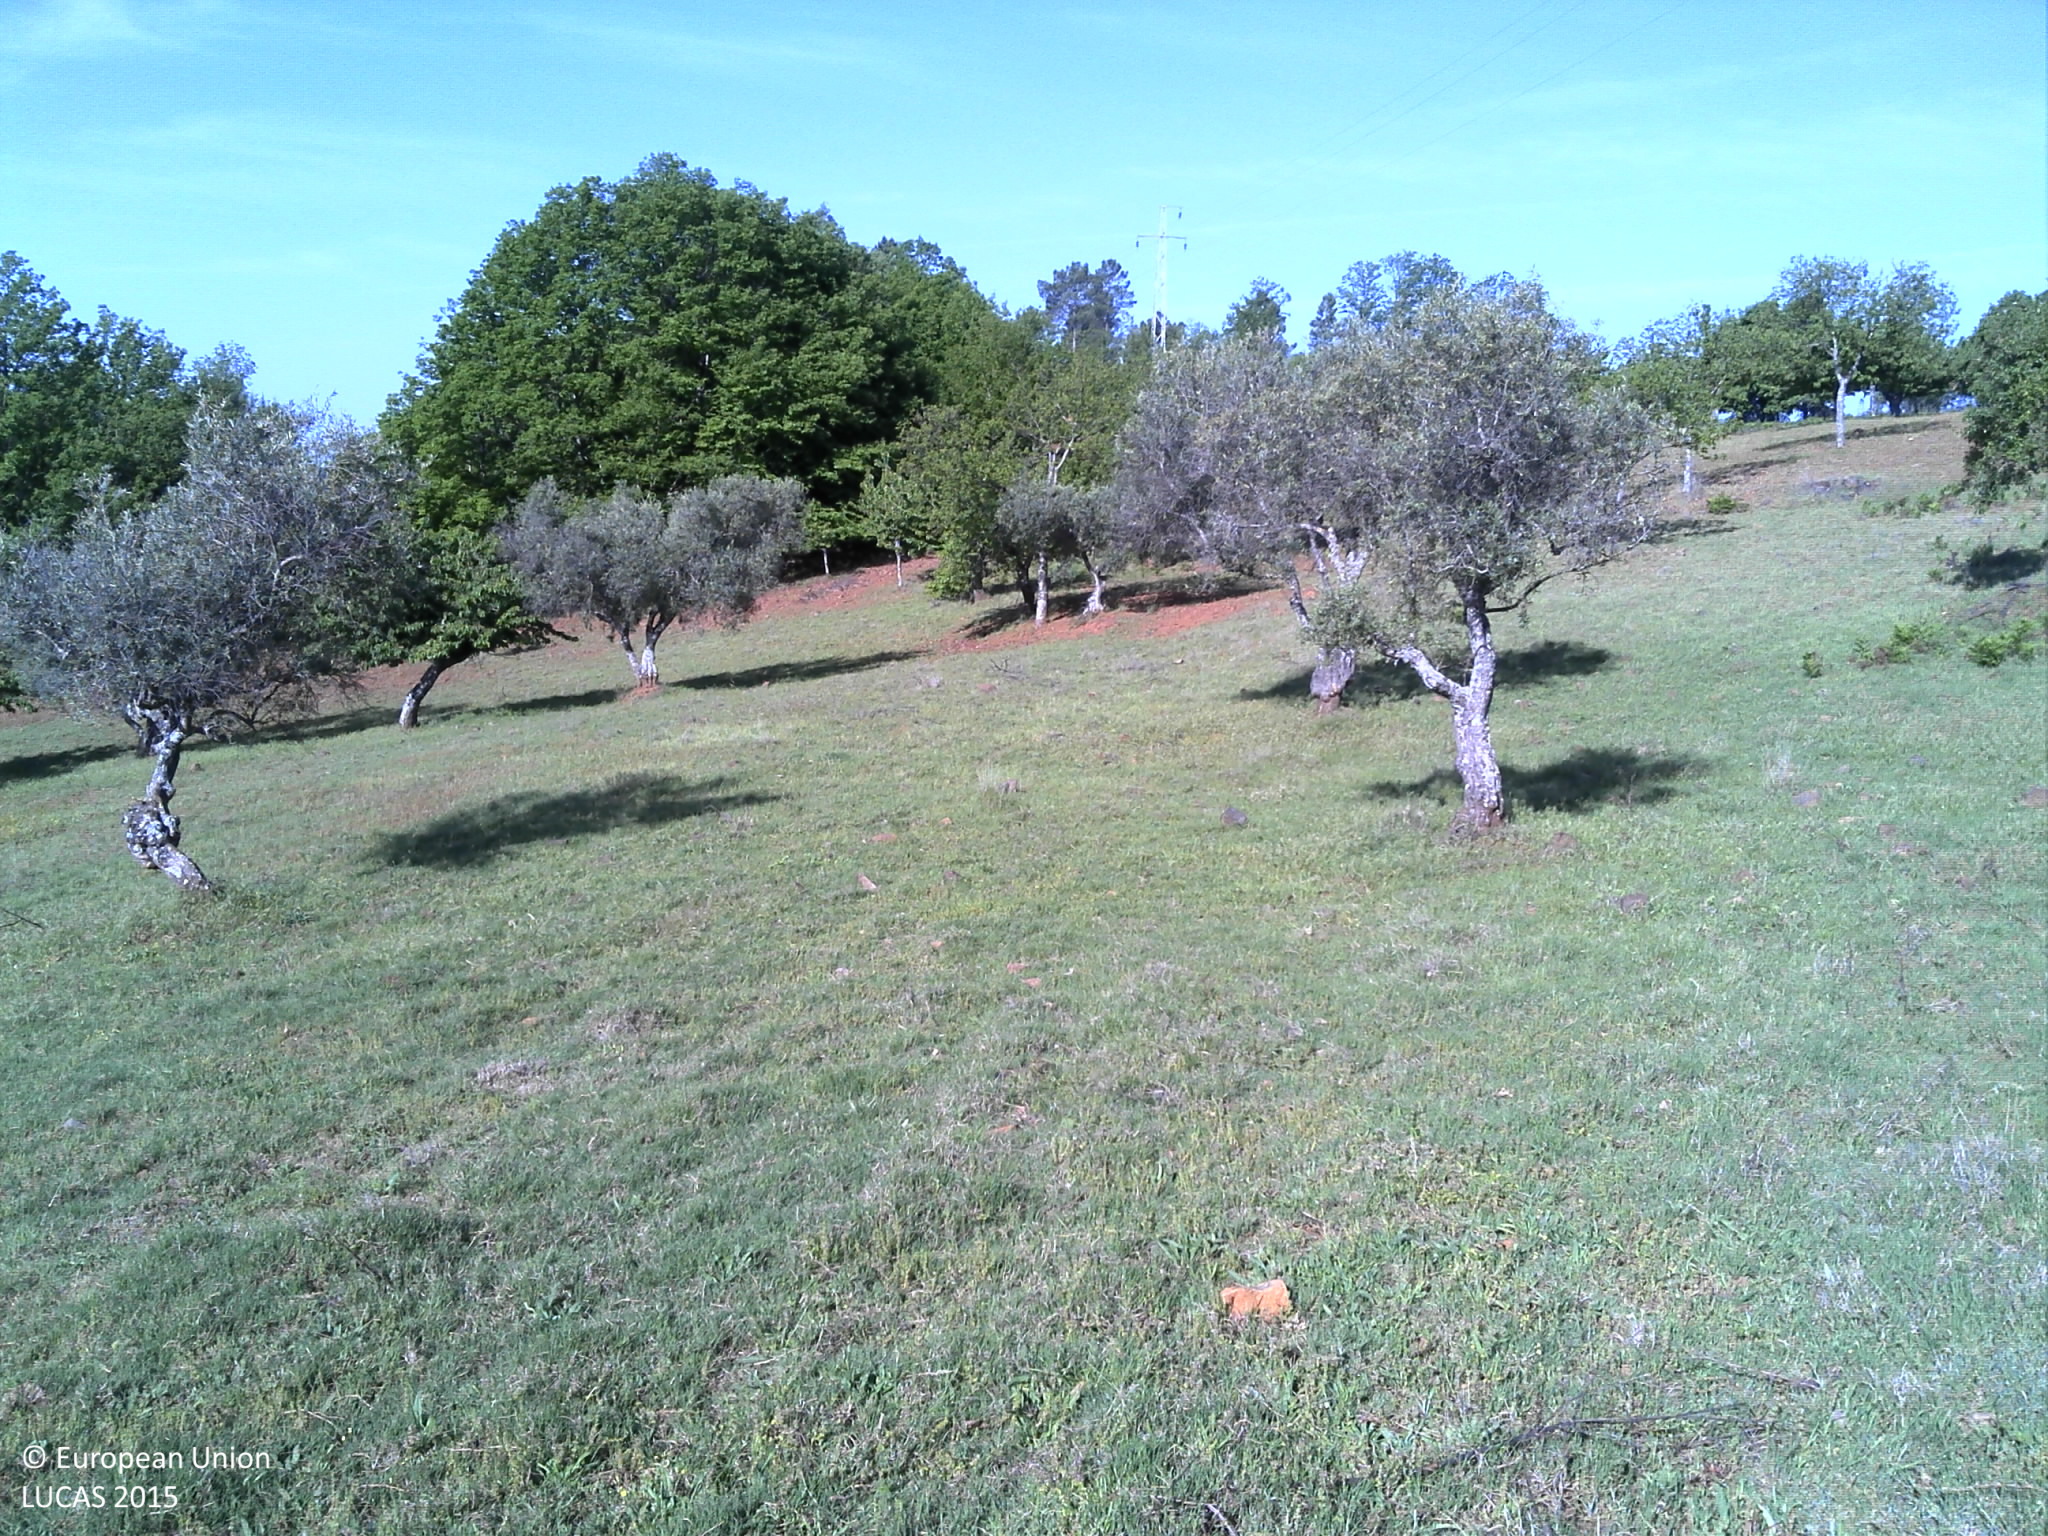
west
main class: Cropland
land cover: Olive groves
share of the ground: 10 - 25 %
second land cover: Grassland without tree/shrub cover
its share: 50 - 75 %
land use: Agriculture (excluding fallow land and kitchen gardens)
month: May
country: PT
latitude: 41.8325
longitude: -6.9890
